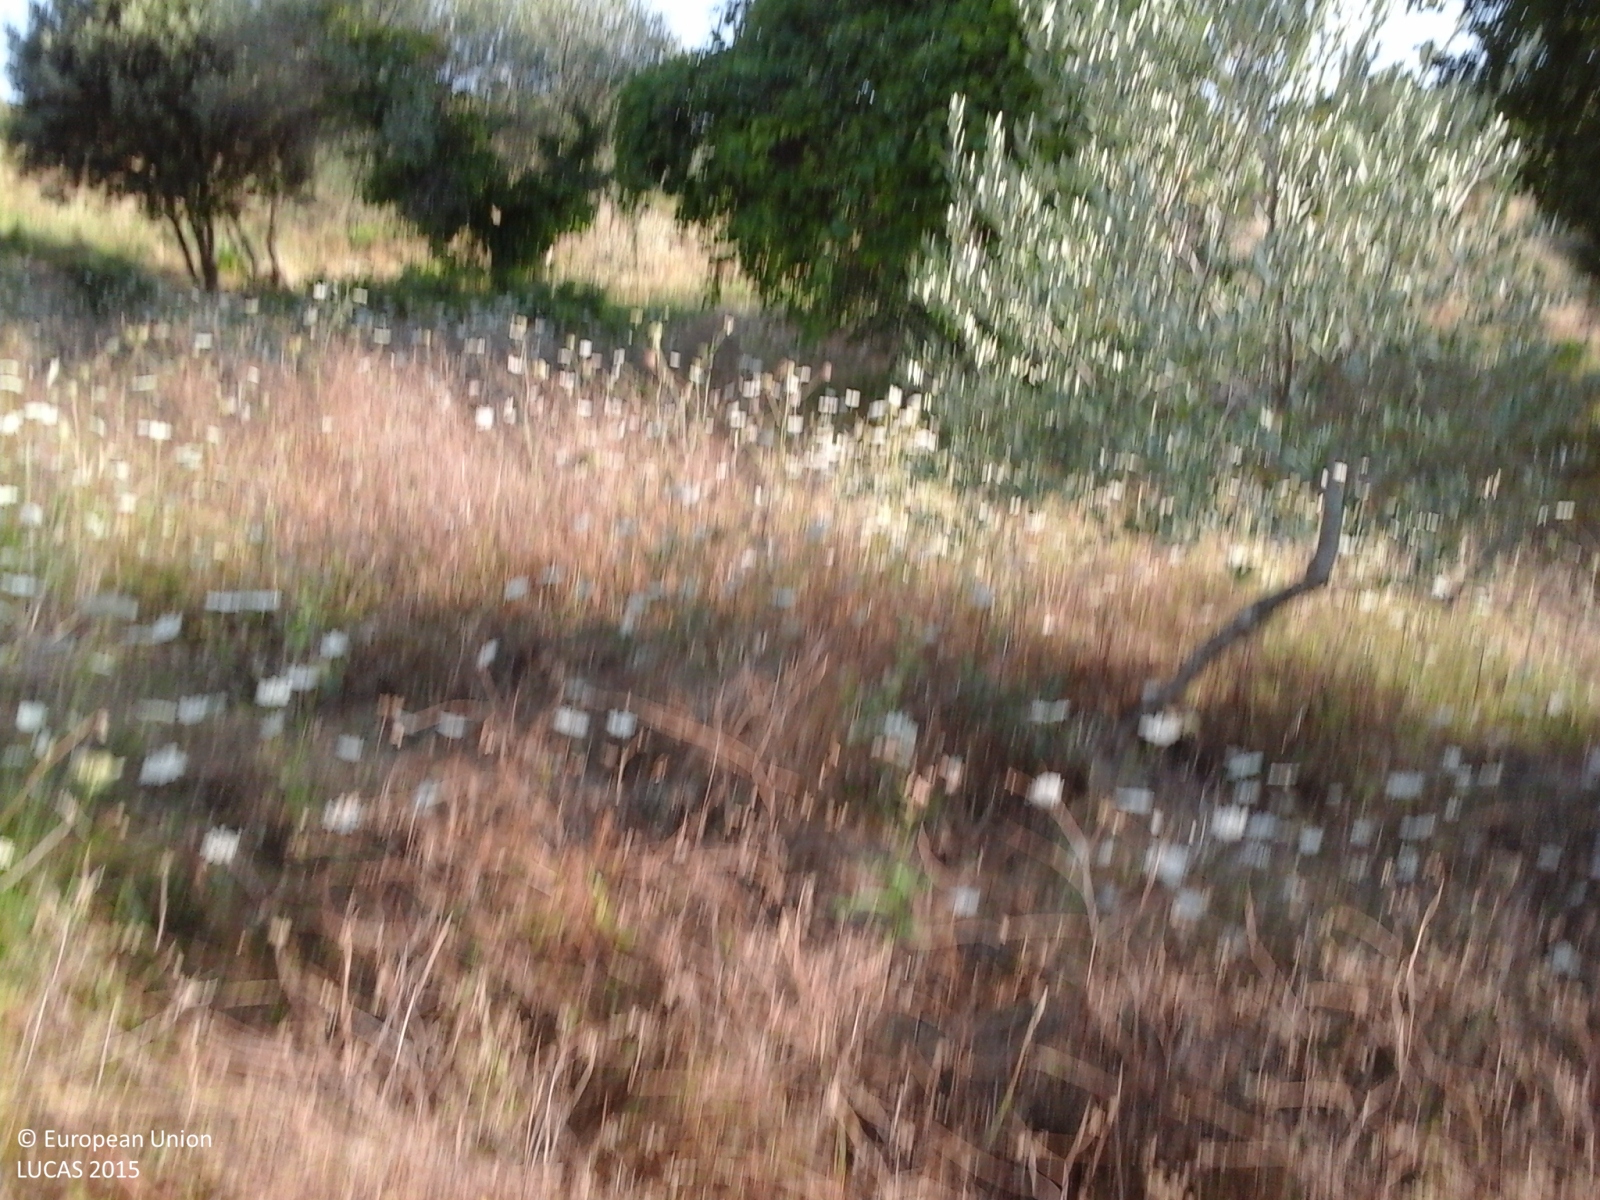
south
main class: Cropland
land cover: Olive groves
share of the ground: > 75 %
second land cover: Temporary grasslands
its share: > 75 %
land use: Agriculture (excluding fallow land and kitchen gardens)
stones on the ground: < 10 %
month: July
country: IT
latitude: 43.0405
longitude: 11.4807
